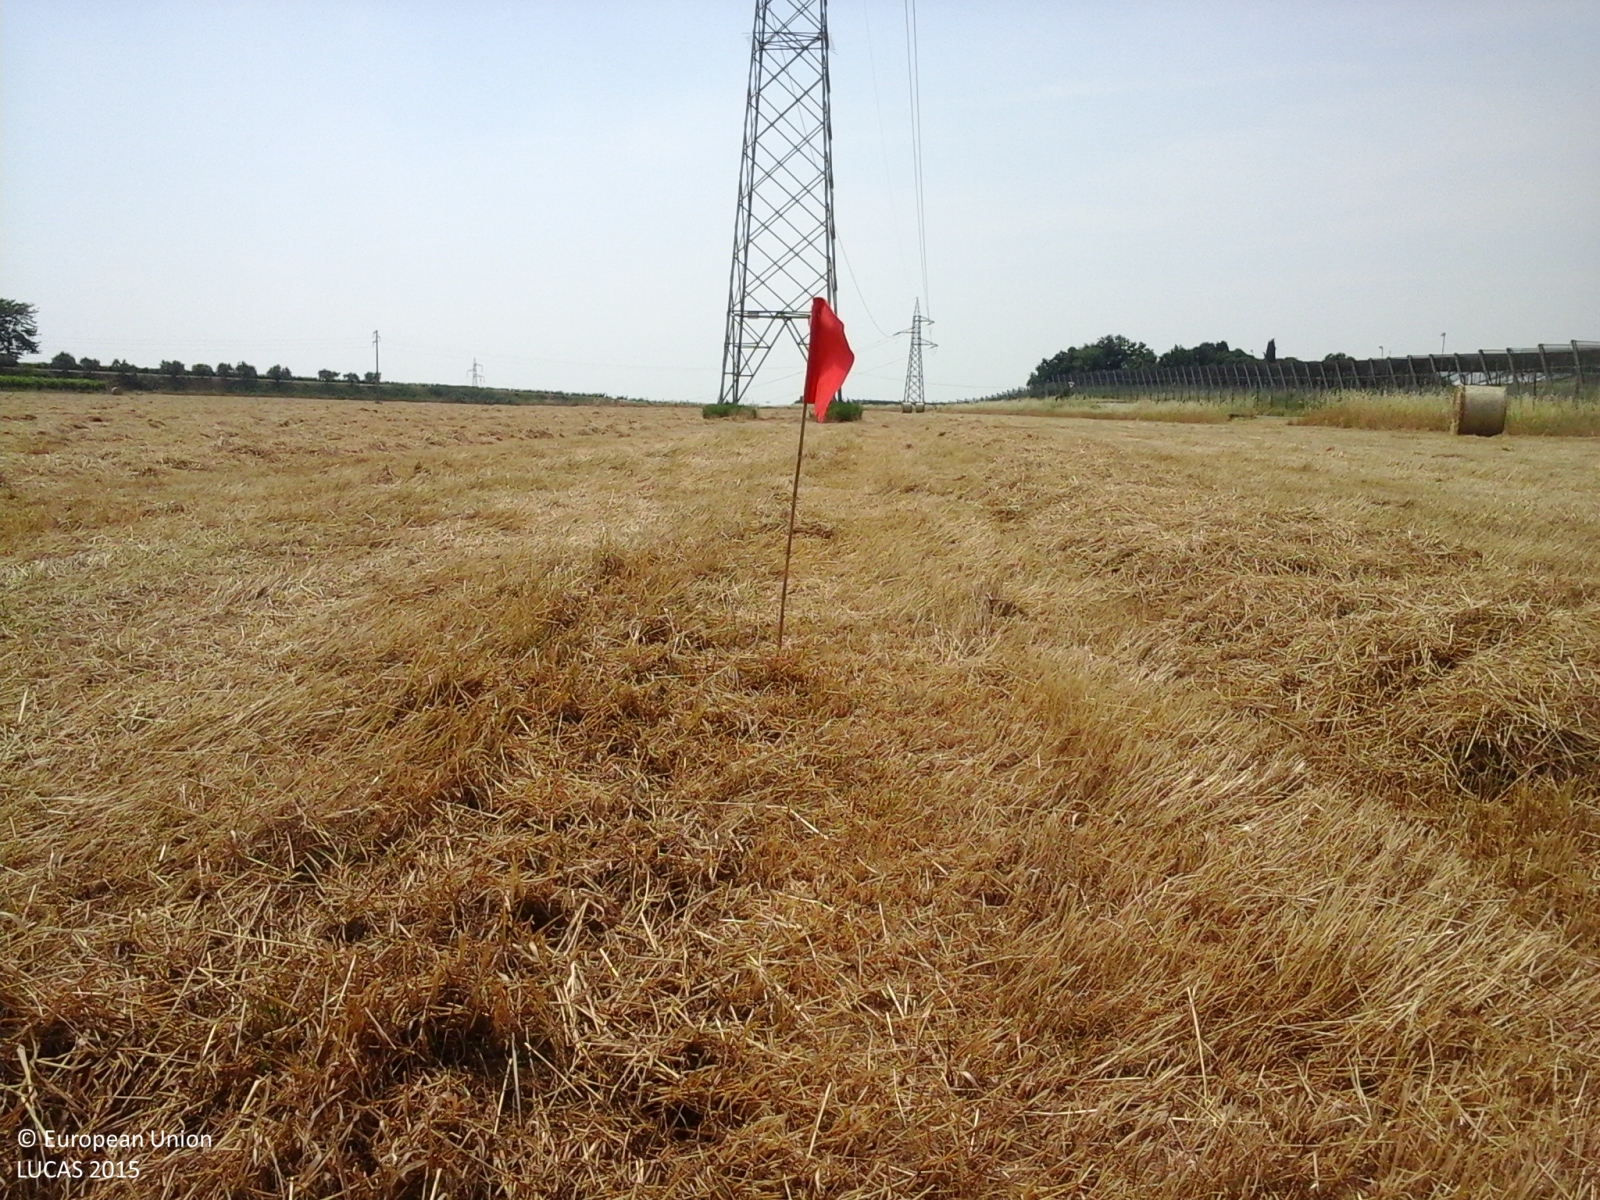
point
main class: Grassland
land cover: Grassland without tree/shrub cover
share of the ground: > 75 %
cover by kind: herbaceous plants 100 %
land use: Agriculture (excluding fallow land and kitchen gardens)
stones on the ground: < 10 %
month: June
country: IT
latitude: 45.3756
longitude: 10.7521
